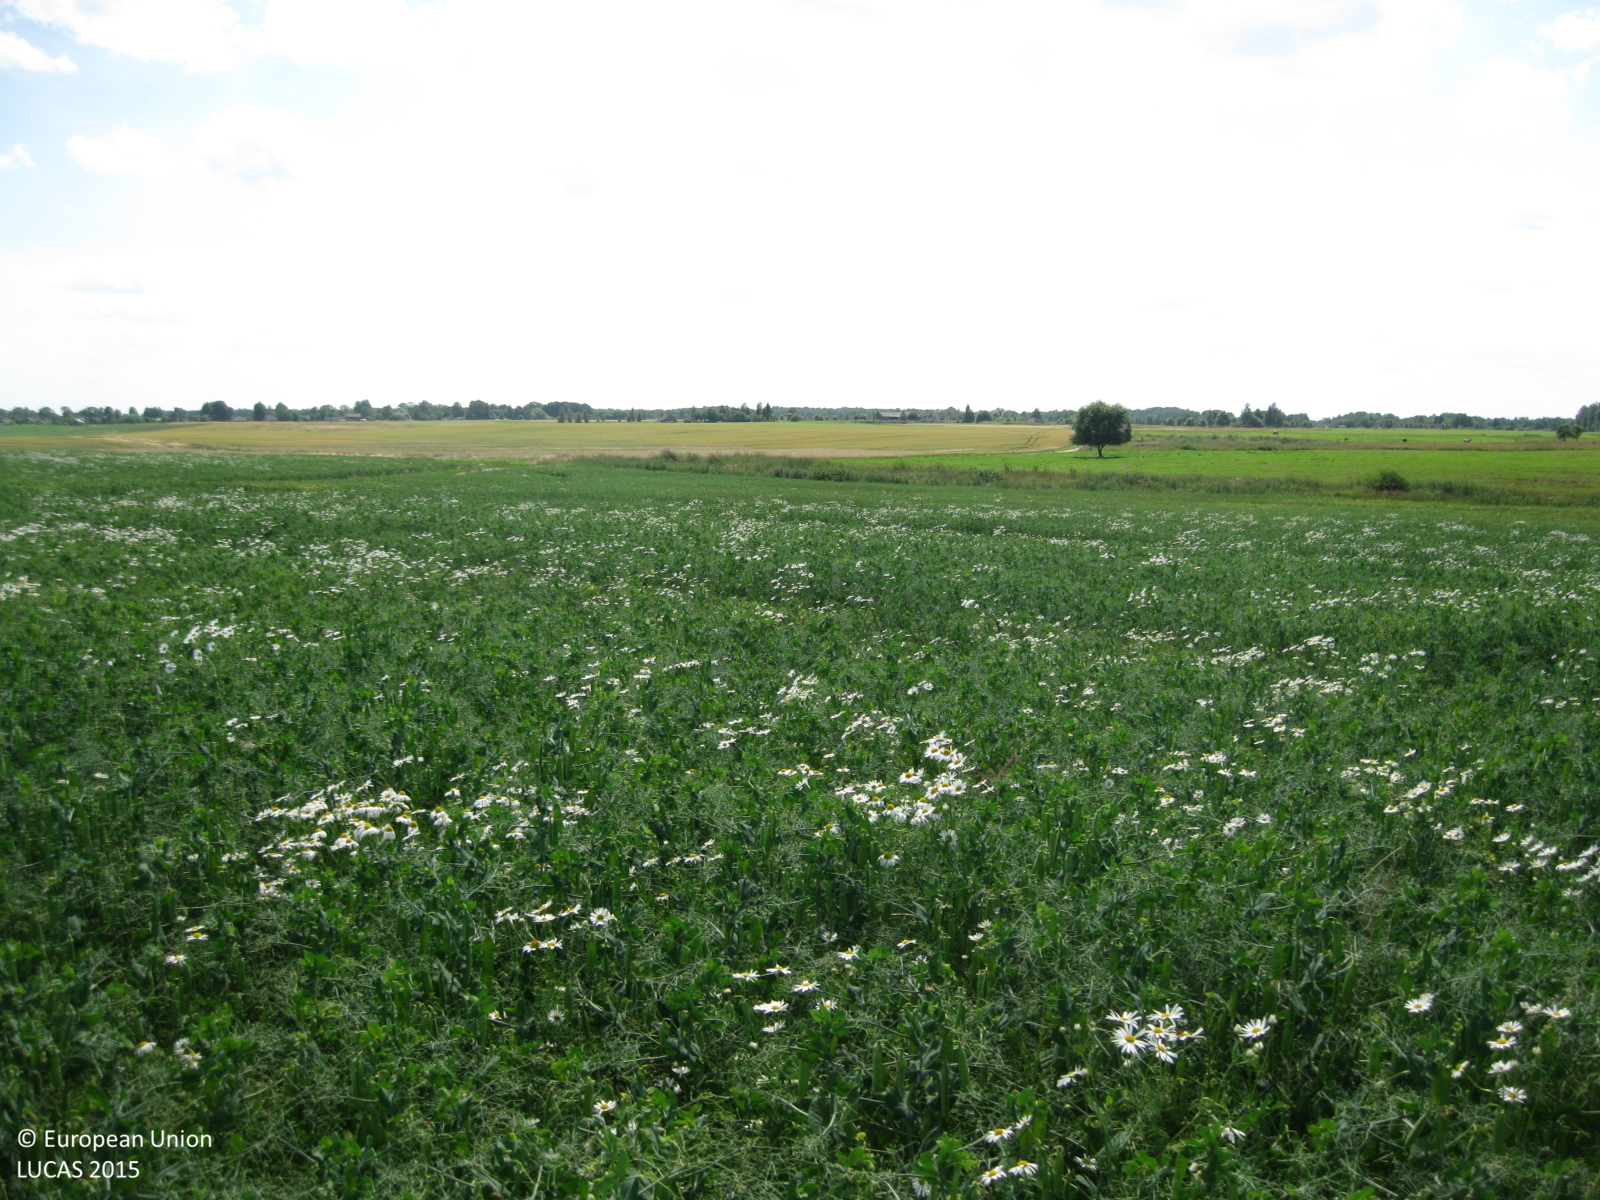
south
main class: Cropland
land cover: Dry pulses
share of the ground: > 75 %
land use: Agriculture (excluding fallow land and kitchen gardens)
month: July
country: LT
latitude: 55.0867
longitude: 24.6275
